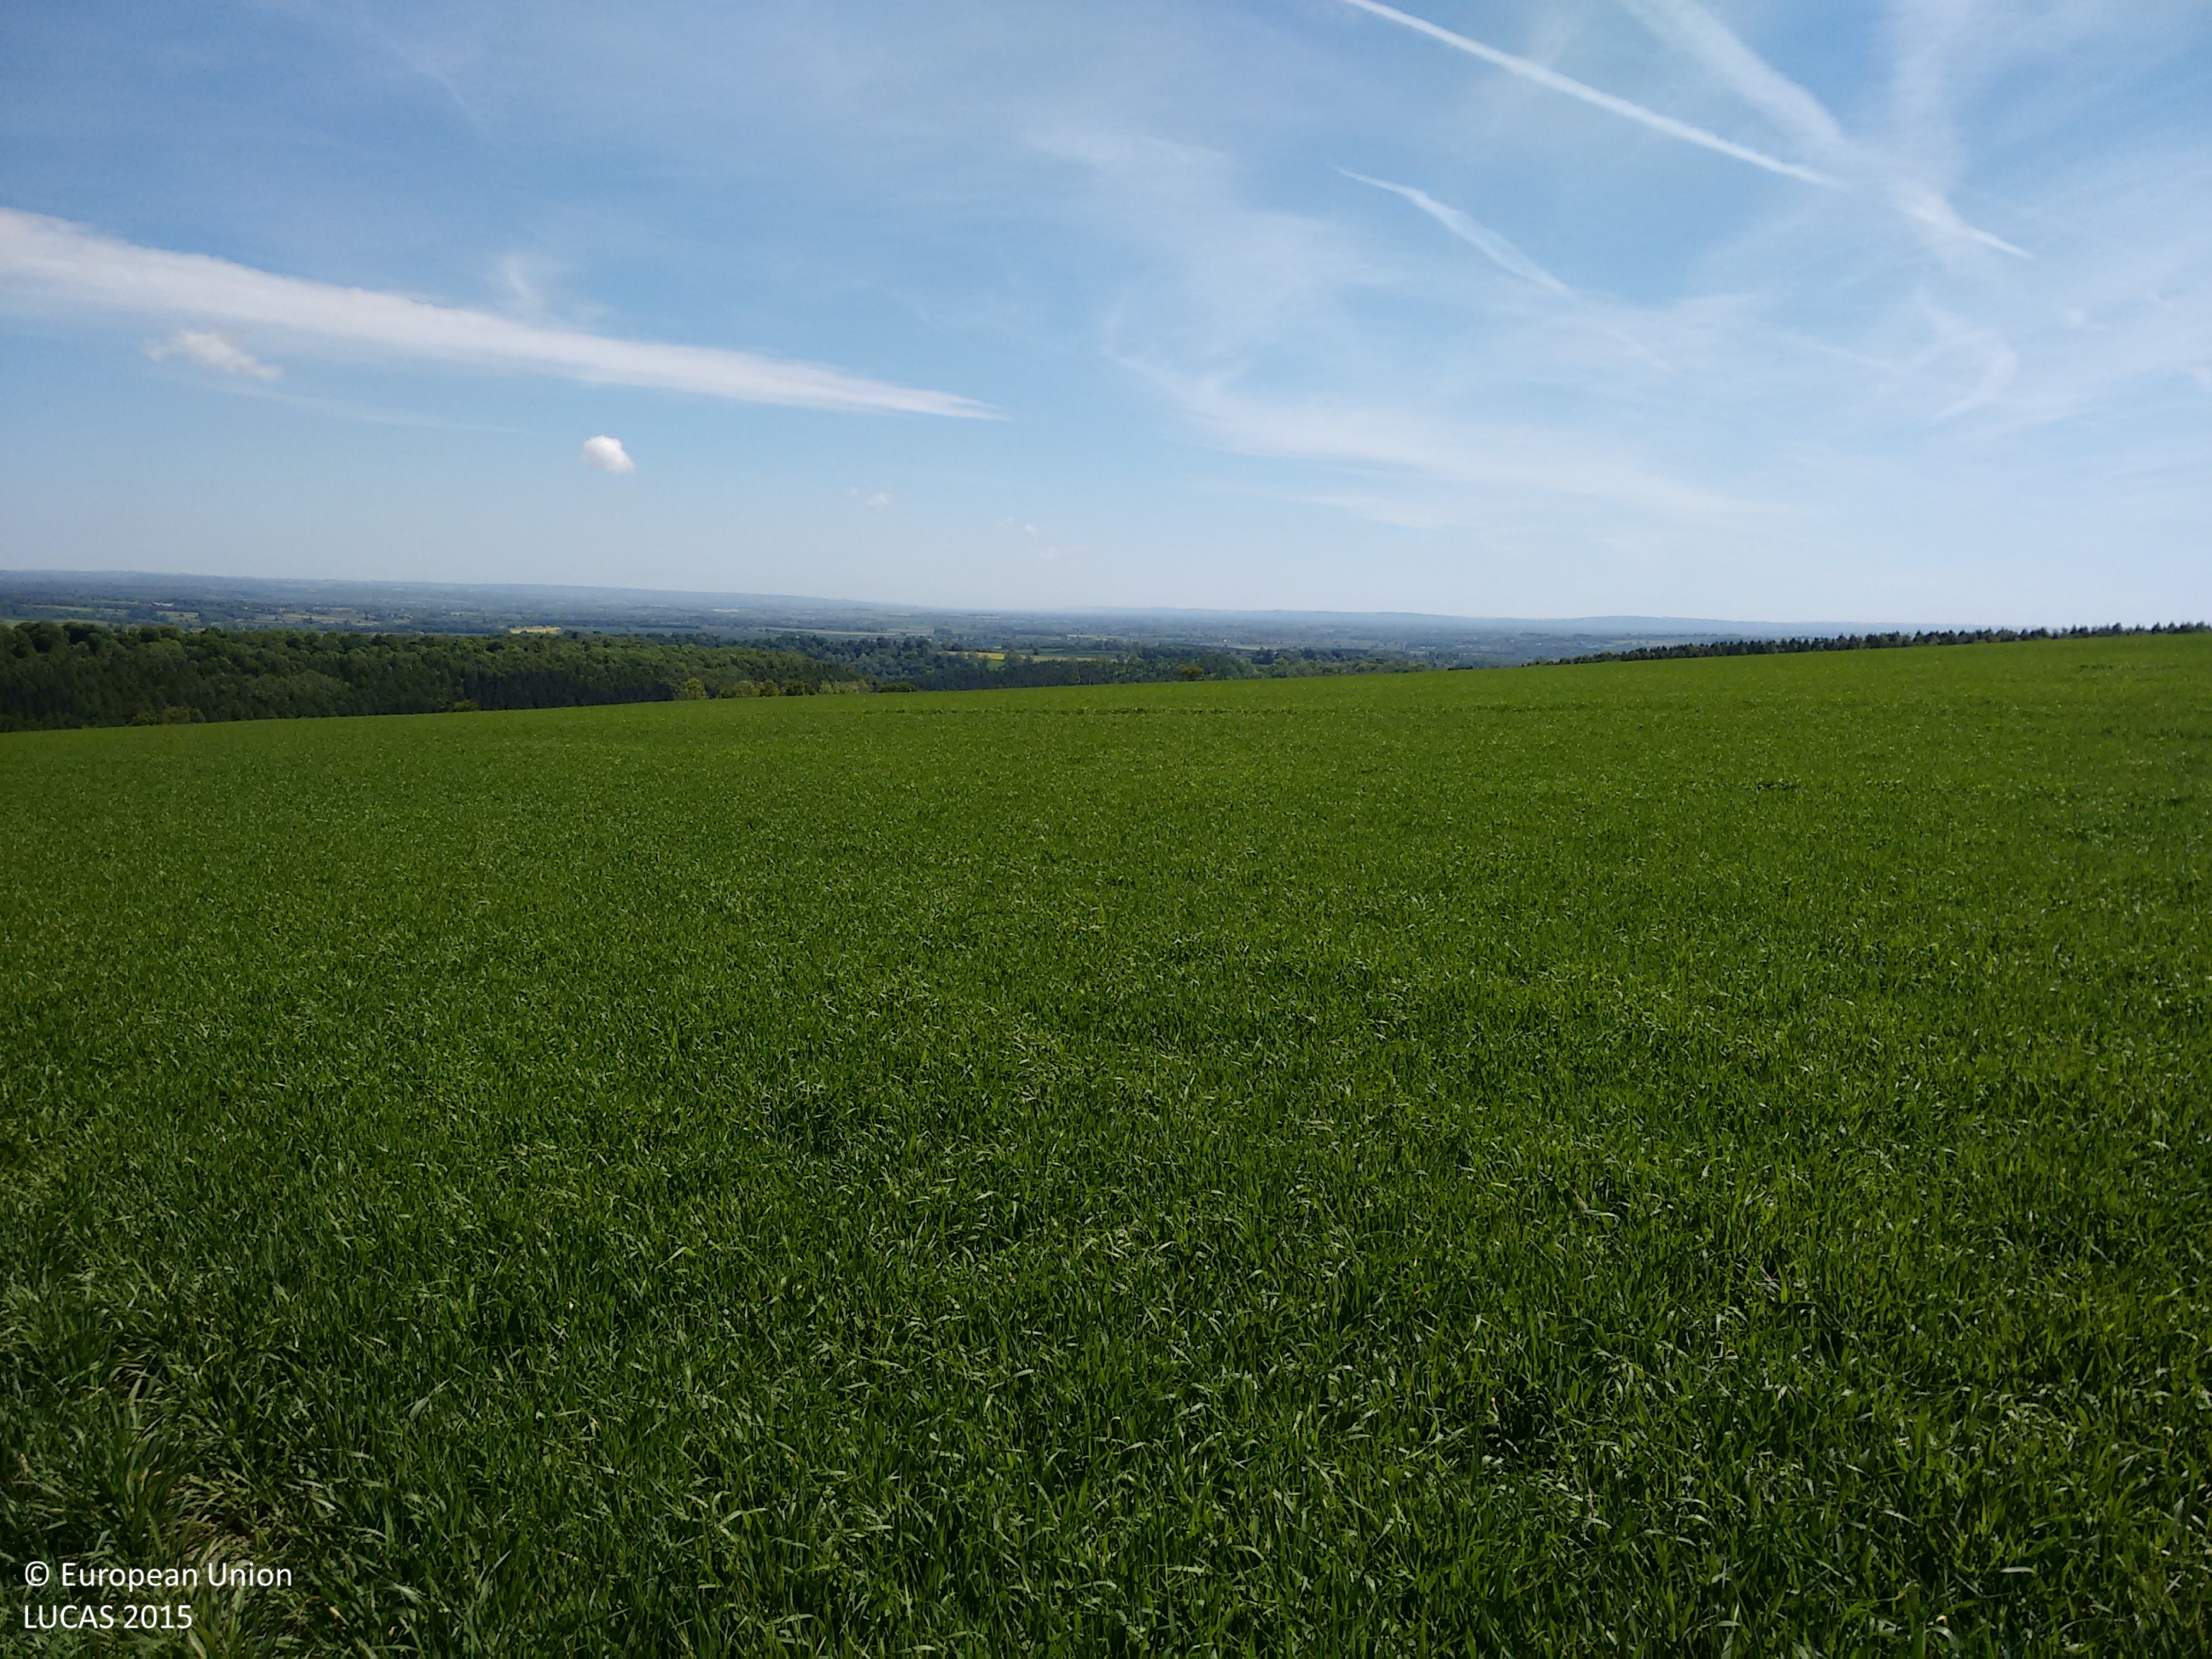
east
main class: Cropland
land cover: Barley
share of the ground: > 75 %
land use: Agriculture (excluding fallow land and kitchen gardens)
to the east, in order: Barley; Grass margins; Other bare soil
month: June
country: GB
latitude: 54.2330
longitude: -1.1048
